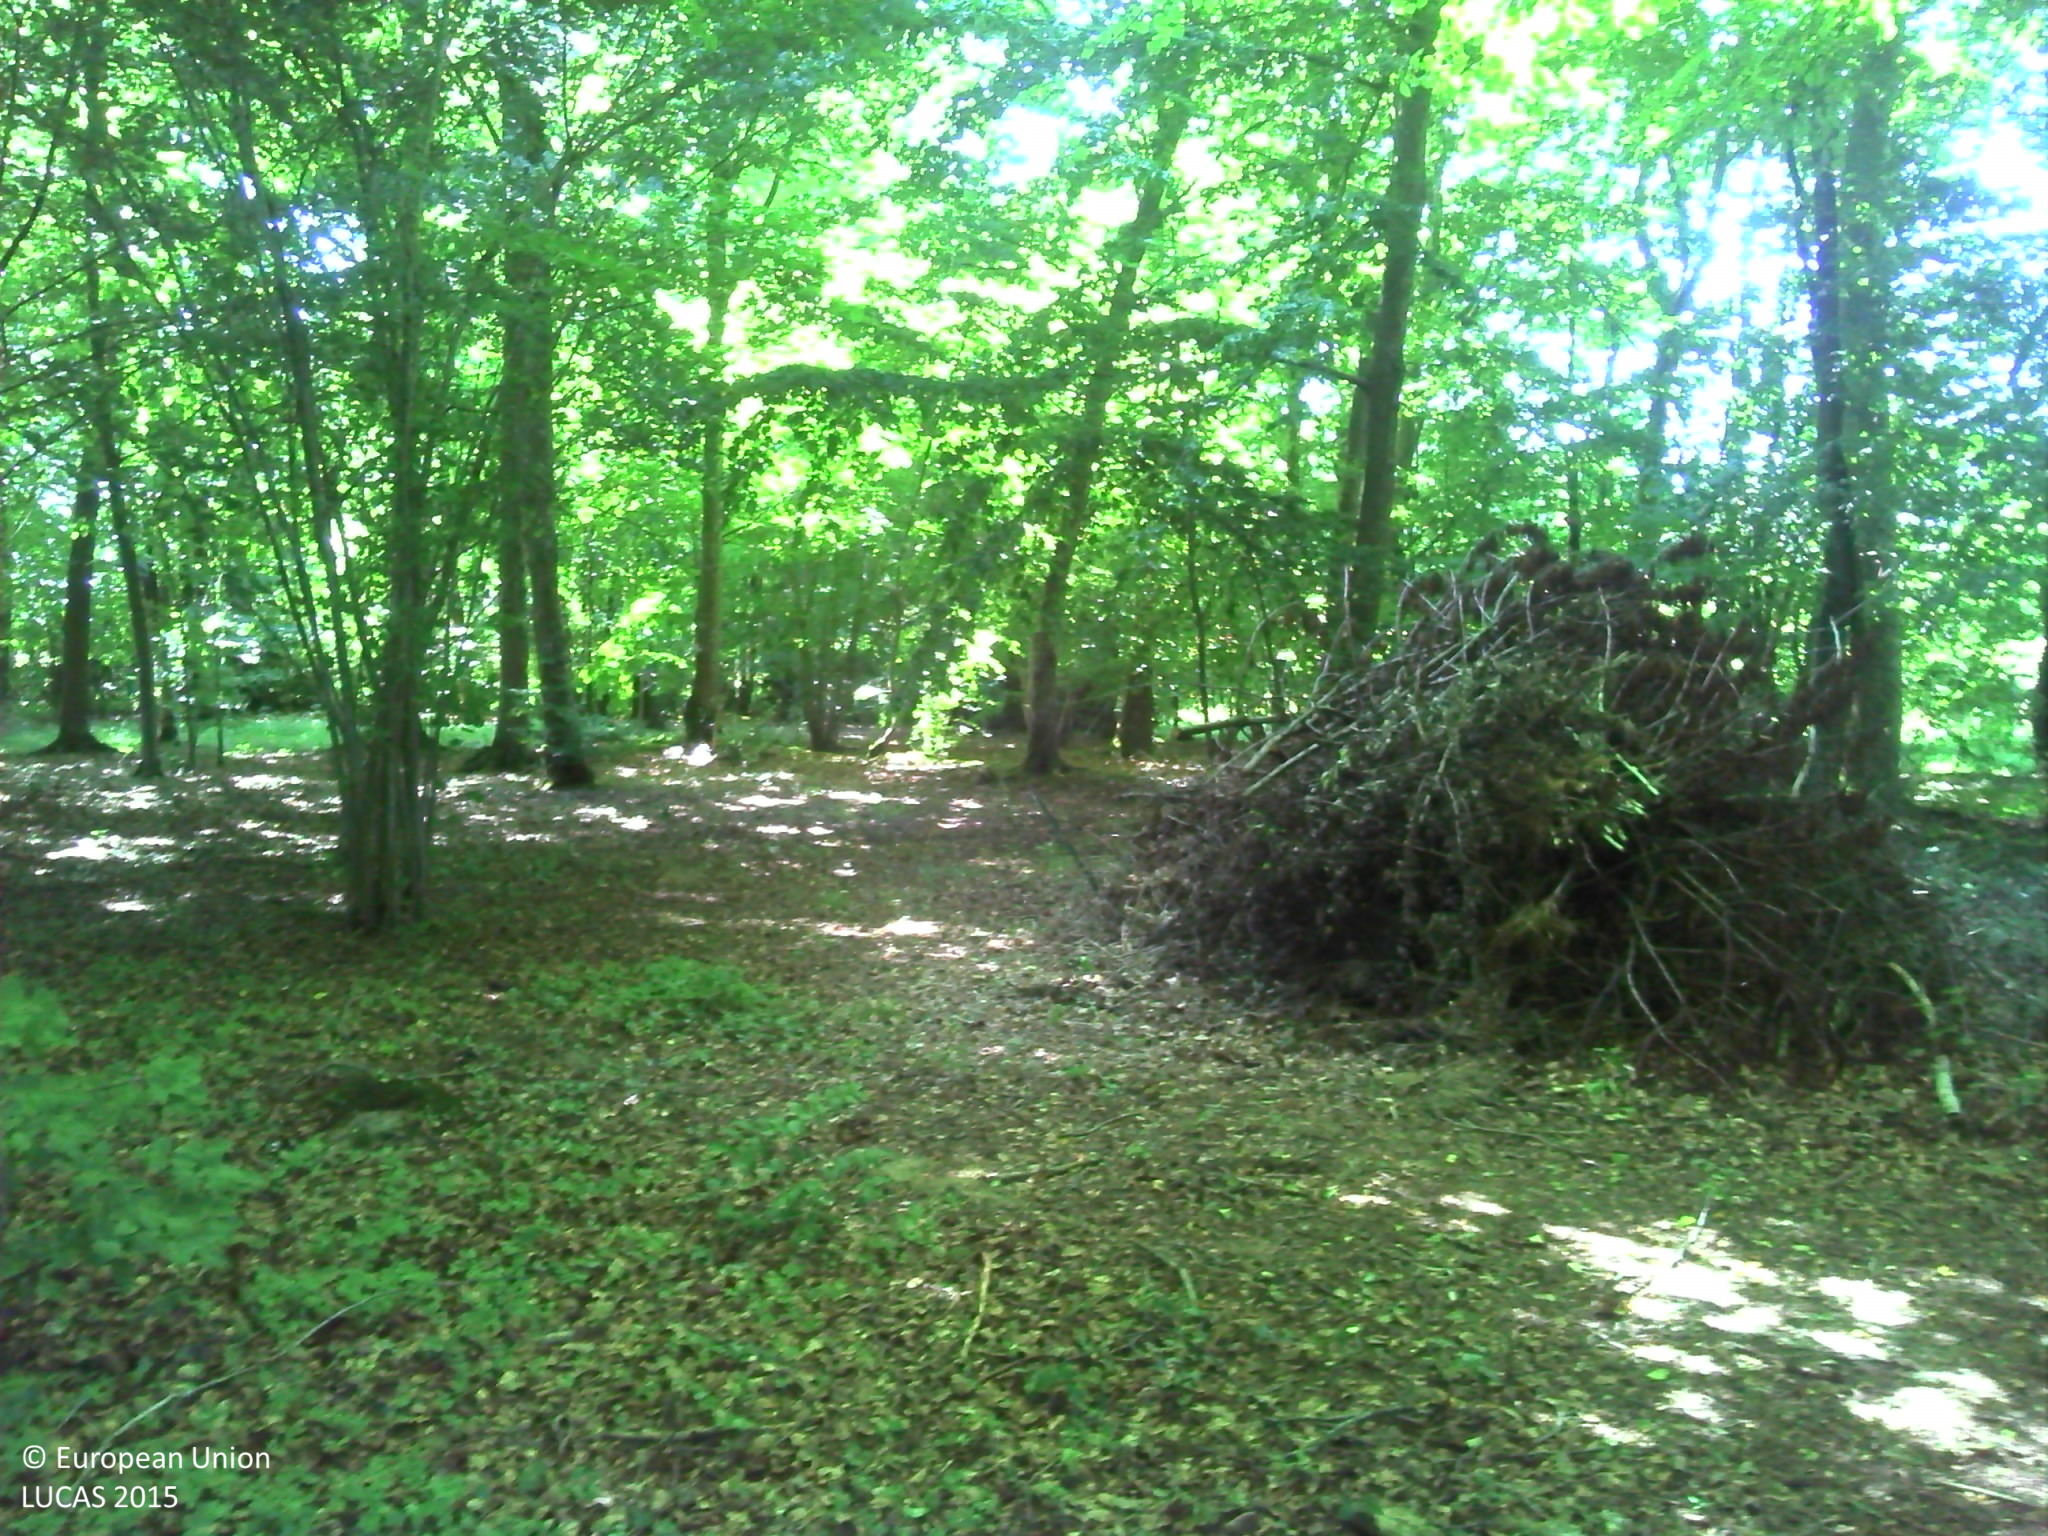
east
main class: Woodland
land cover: Broadleaved woodland
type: mesophytic deciduous forest
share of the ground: > 75 %
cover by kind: broadleaved forest trees 80 %, consolidated bare surface 10 %, coniferous forest trees 5 %, herbaceous plants 5 %
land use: Forestry
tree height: > 5 m
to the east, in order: Broadleaved woodland; Fences; Grassland without tree/shrub cover; Fences; Ditches and canals; Fences; Grassland without tree/shrub cover
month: July
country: FR
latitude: 49.0080
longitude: 0.5000
